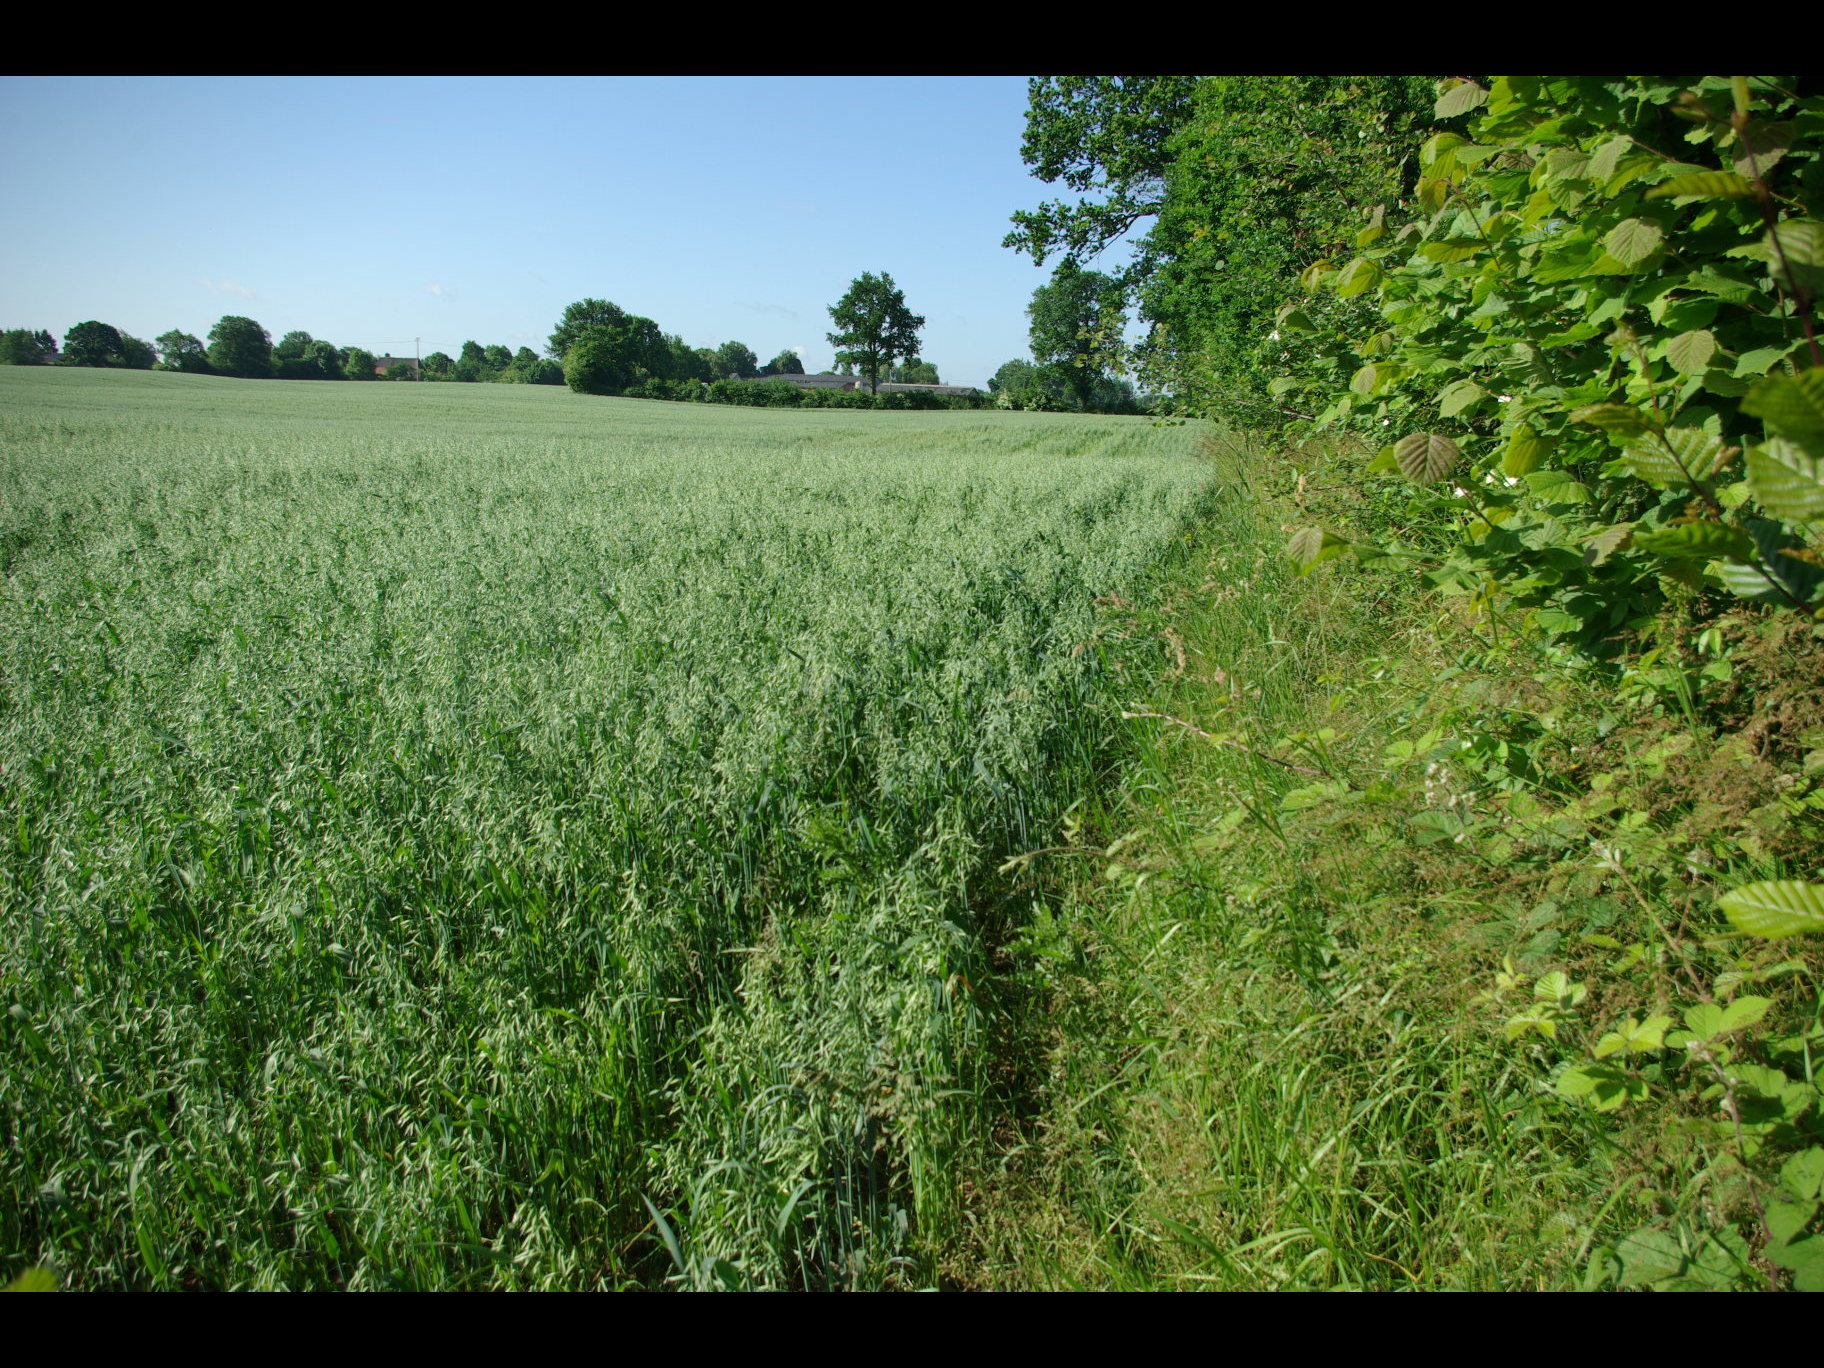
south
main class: Woodland
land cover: Broadleaved woodland
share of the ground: > 75 %
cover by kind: broadleaved forest trees 40 %, shrubs 40 %, herbaceous plants 20 %
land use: Agriculture (excluding fallow land and kitchen gardens)
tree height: > 5 m
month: June
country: DE
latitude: 54.3724
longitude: 9.9538
